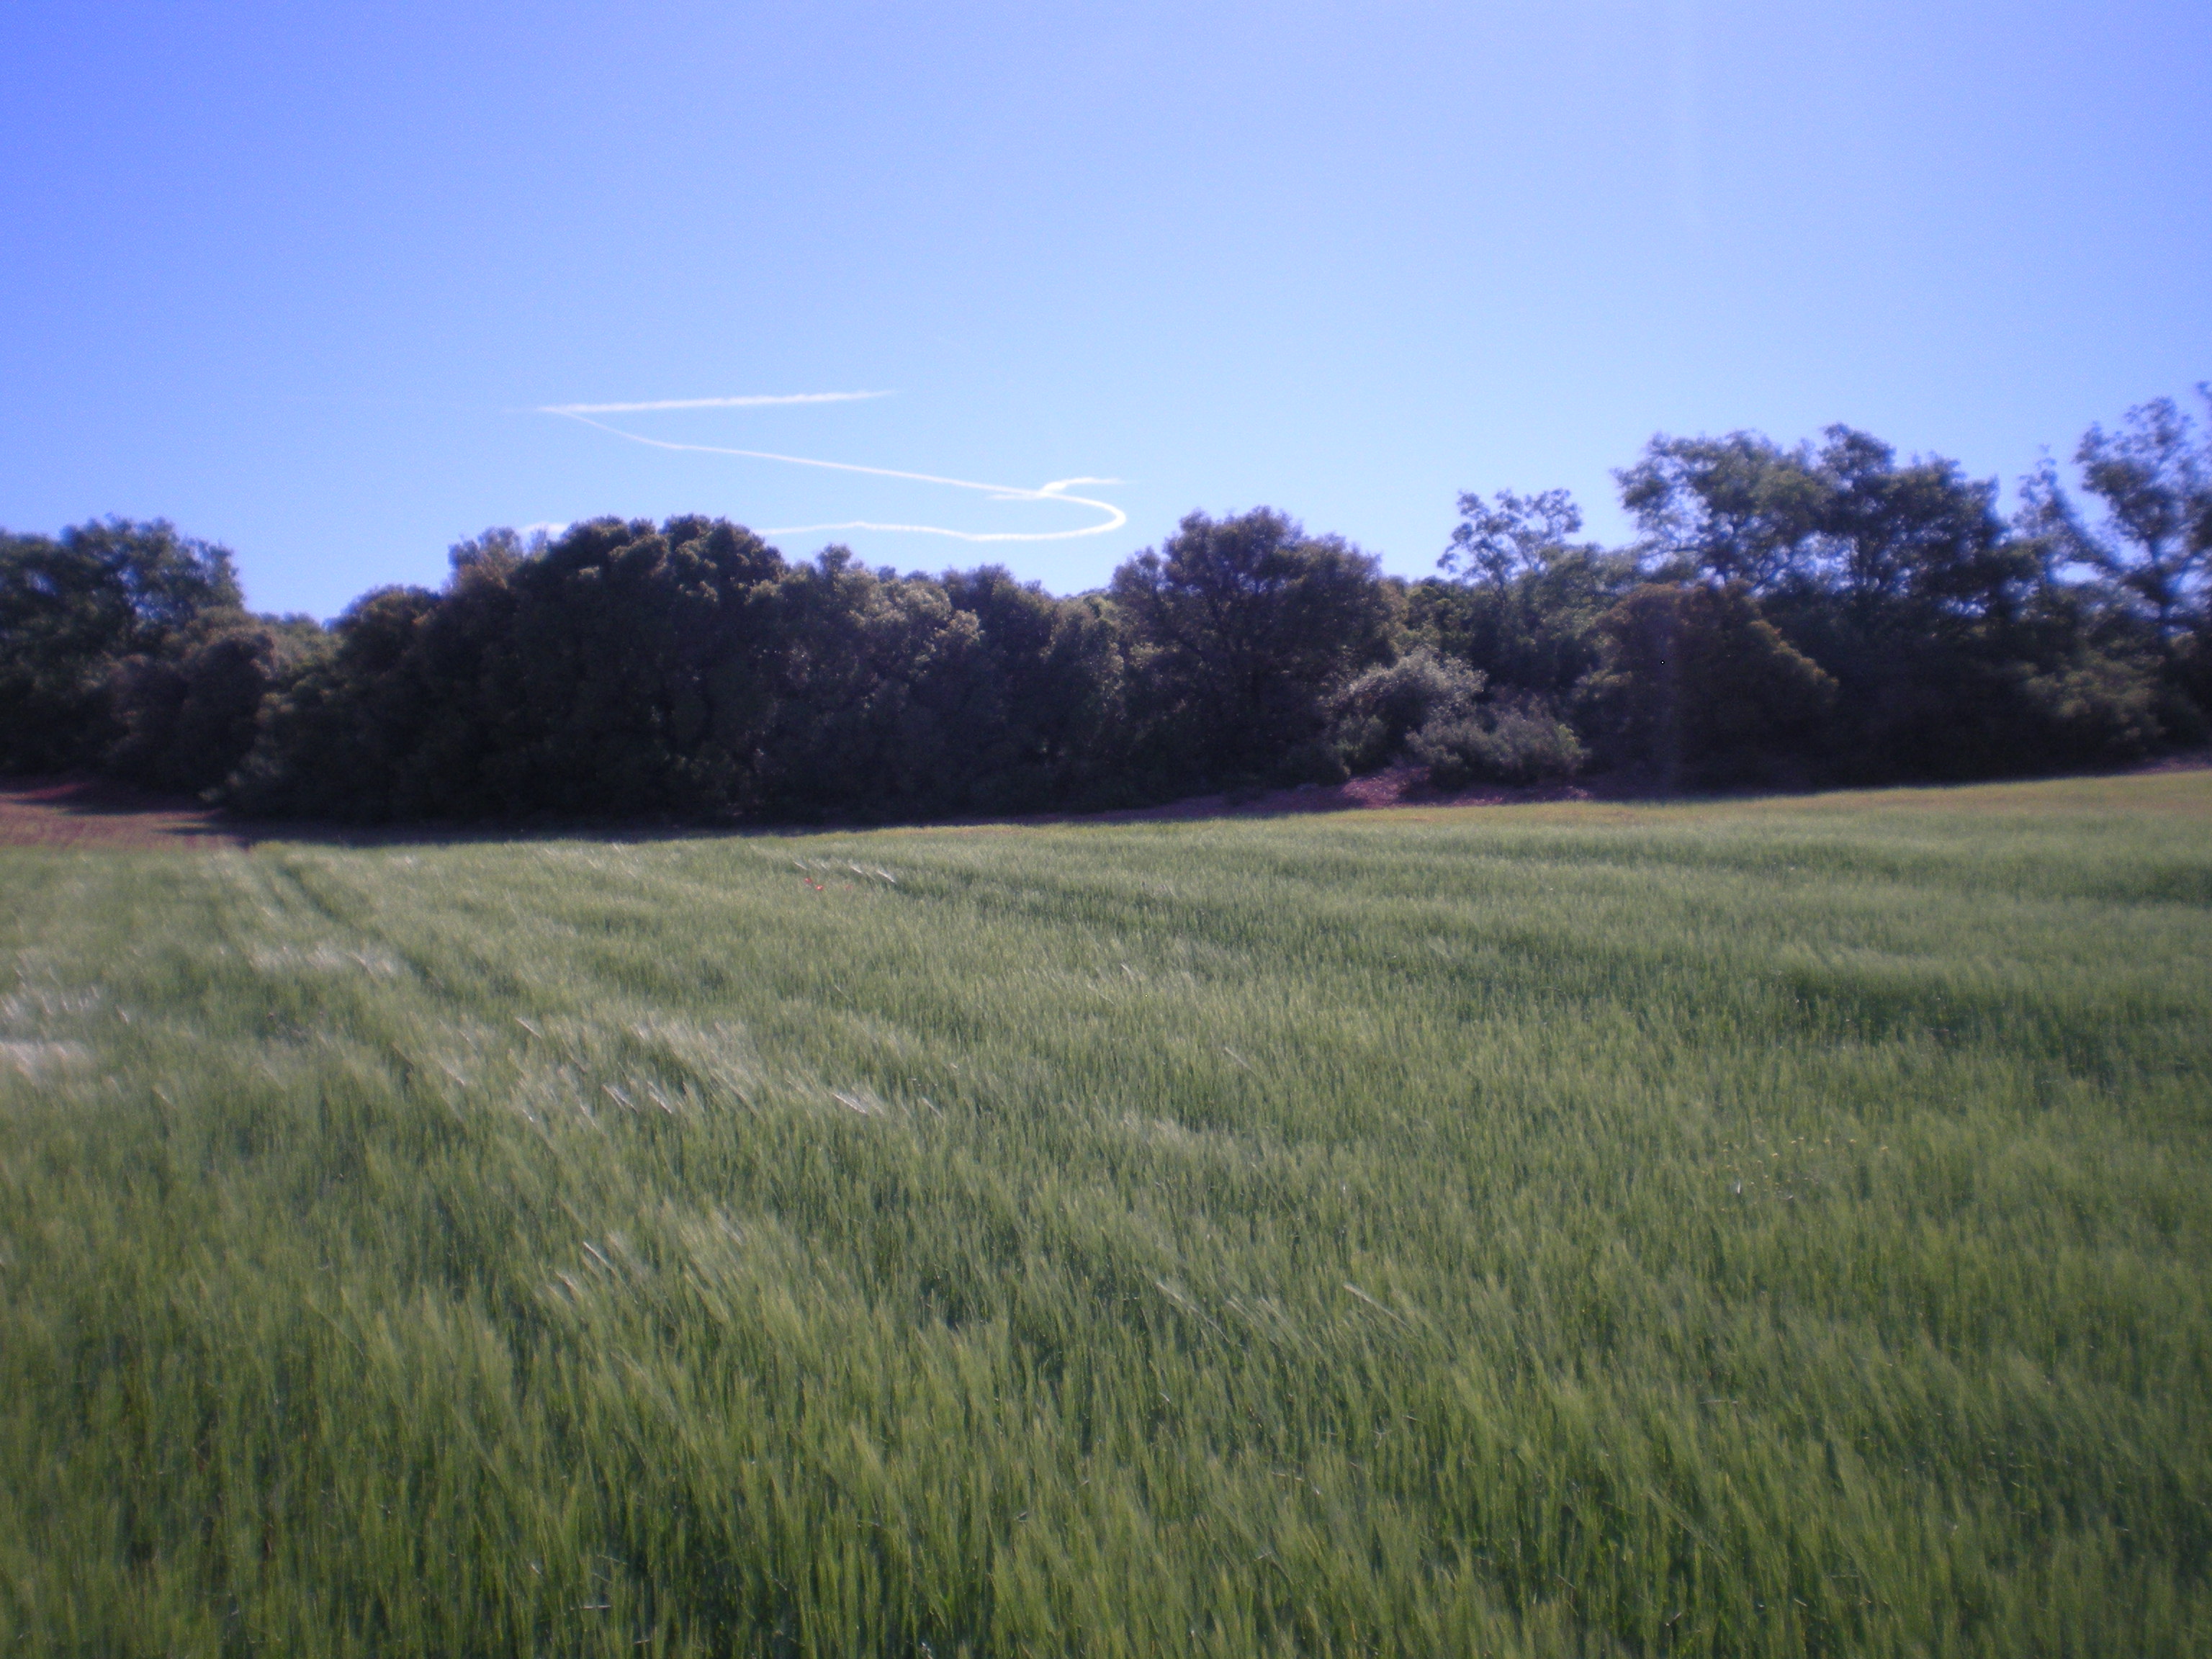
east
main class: Cropland
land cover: Barley
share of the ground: > 75 %
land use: Agriculture (excluding fallow land and kitchen gardens)
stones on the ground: 10 - 25 %
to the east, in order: Barley; Broadleaved woodland; Tracks; Broadleaved woodland; Barley; Broadleaved woodland
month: May
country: ES
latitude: 38.9360
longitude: -3.0343
